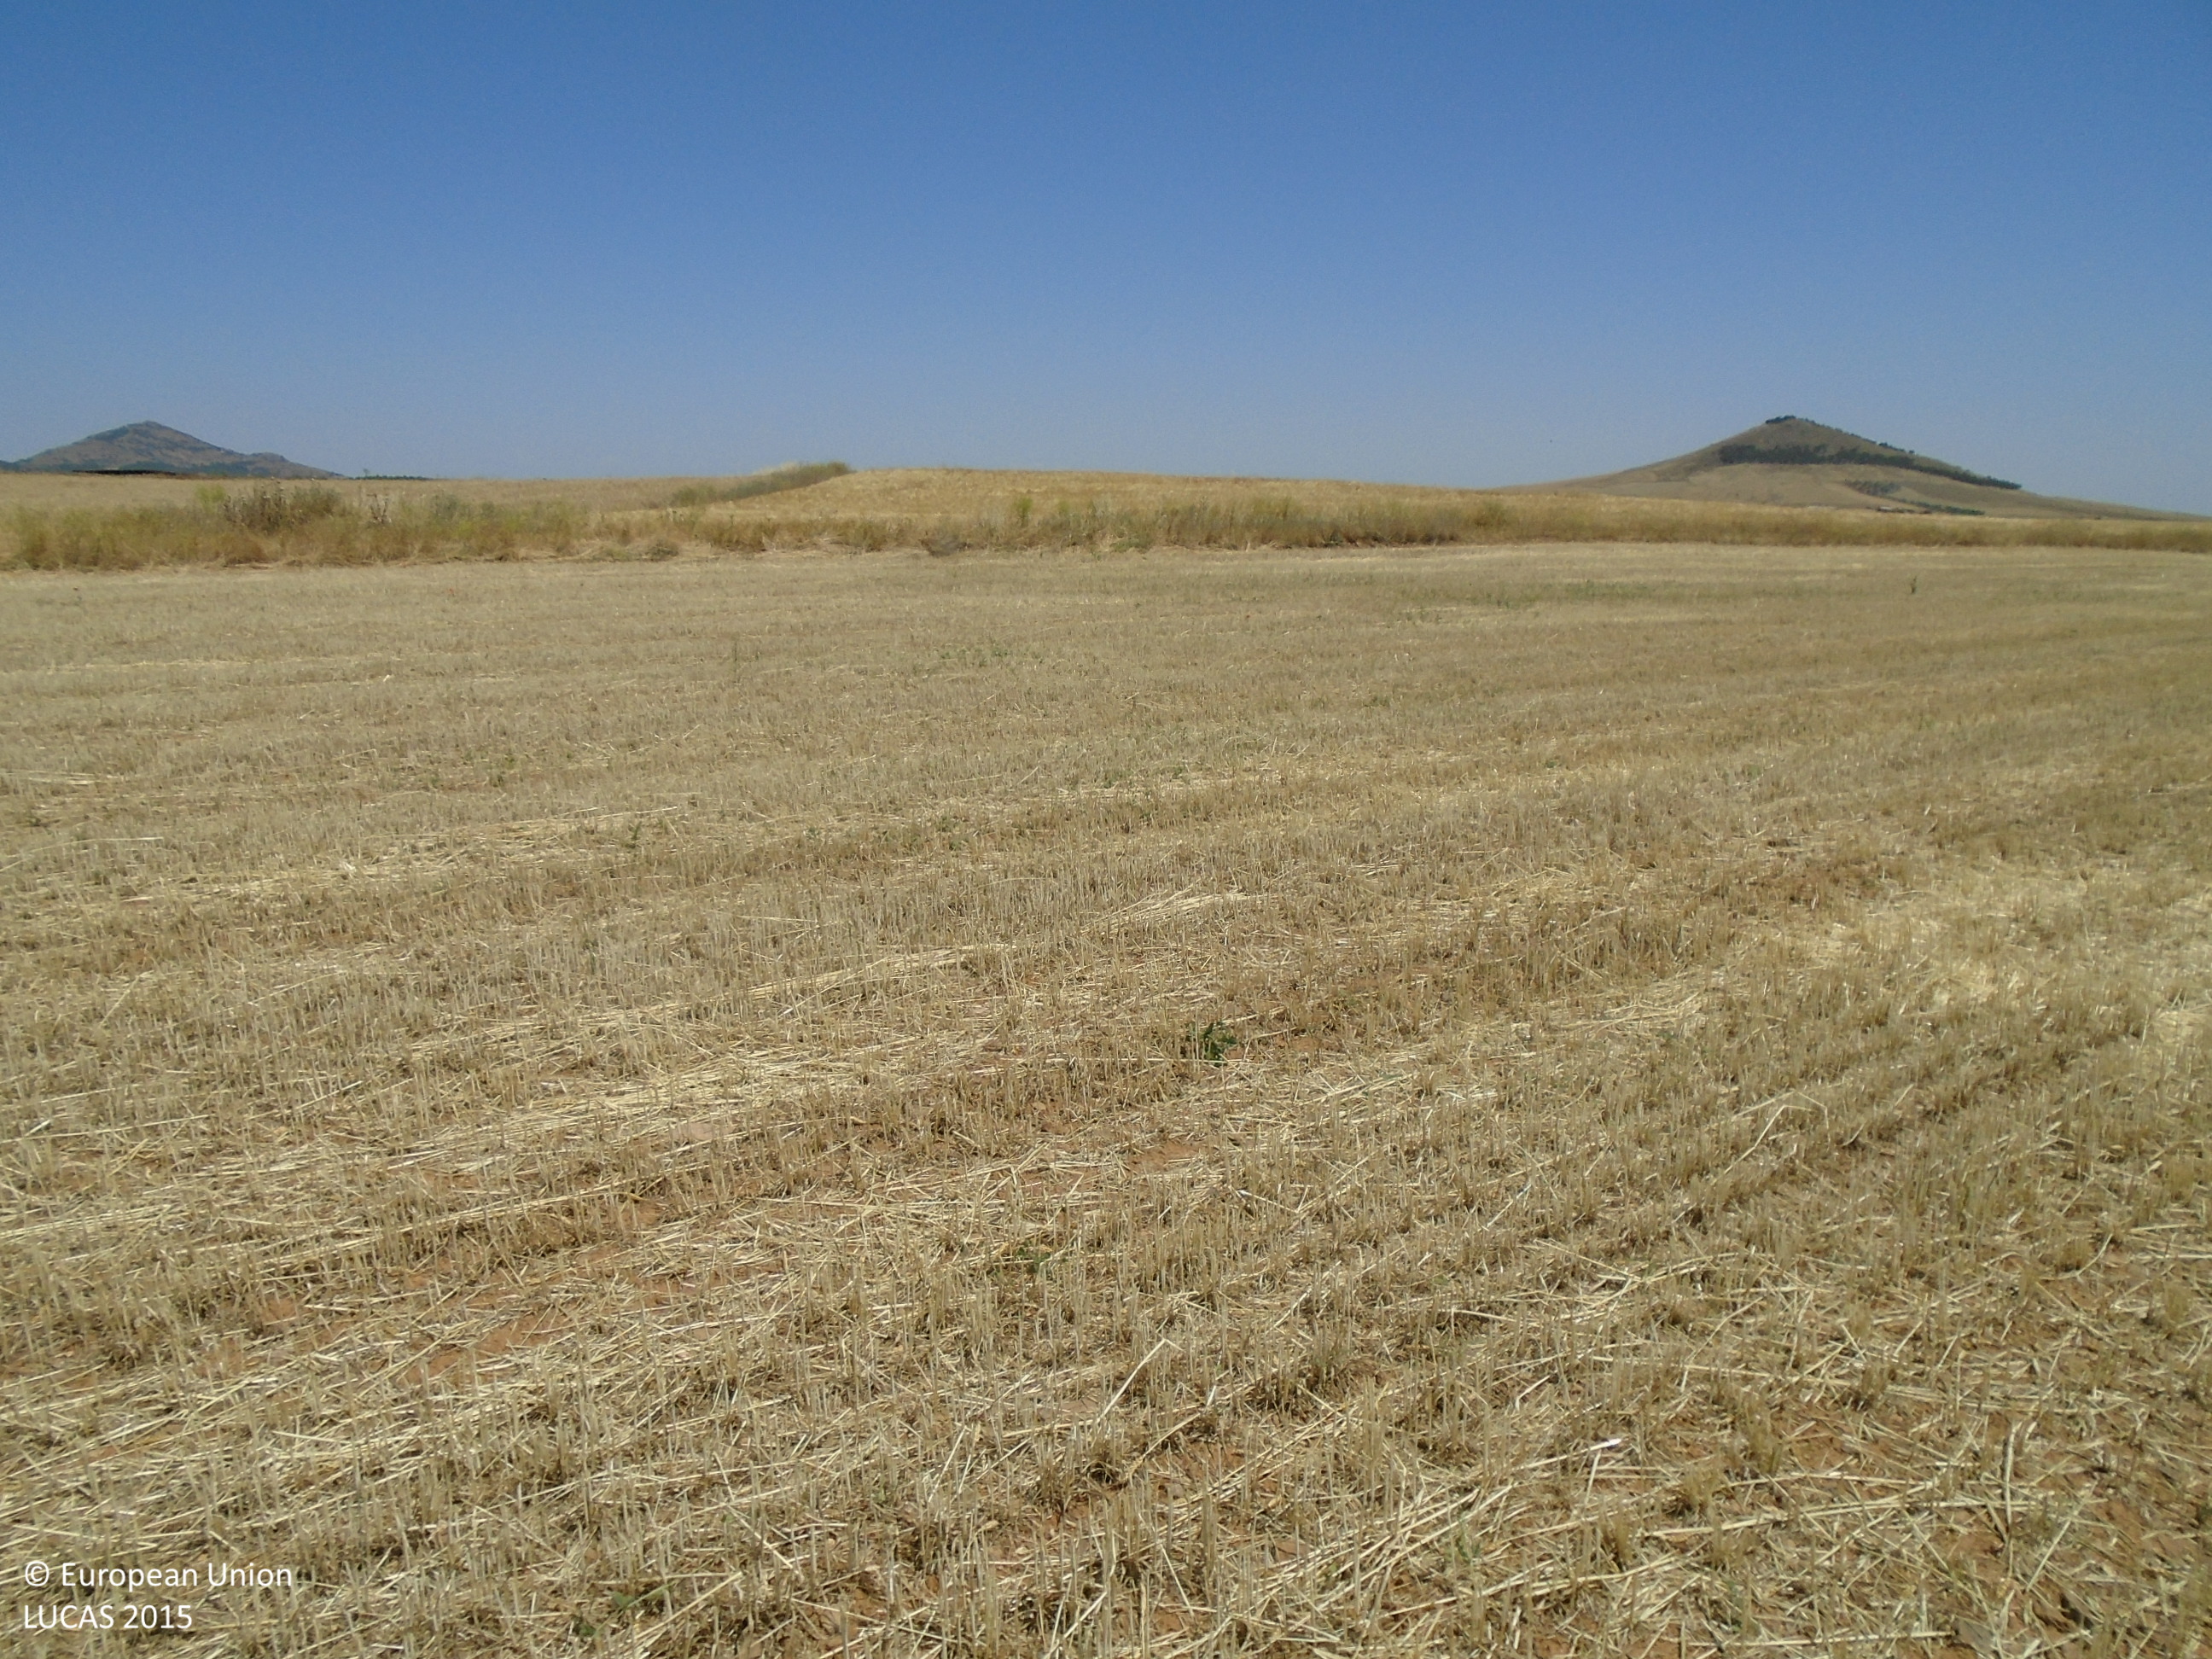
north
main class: Cropland
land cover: Barley
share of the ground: > 75 %
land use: Agriculture (excluding fallow land and kitchen gardens)
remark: Harvested field
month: June
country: ES
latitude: 39.6903
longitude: -4.1786
